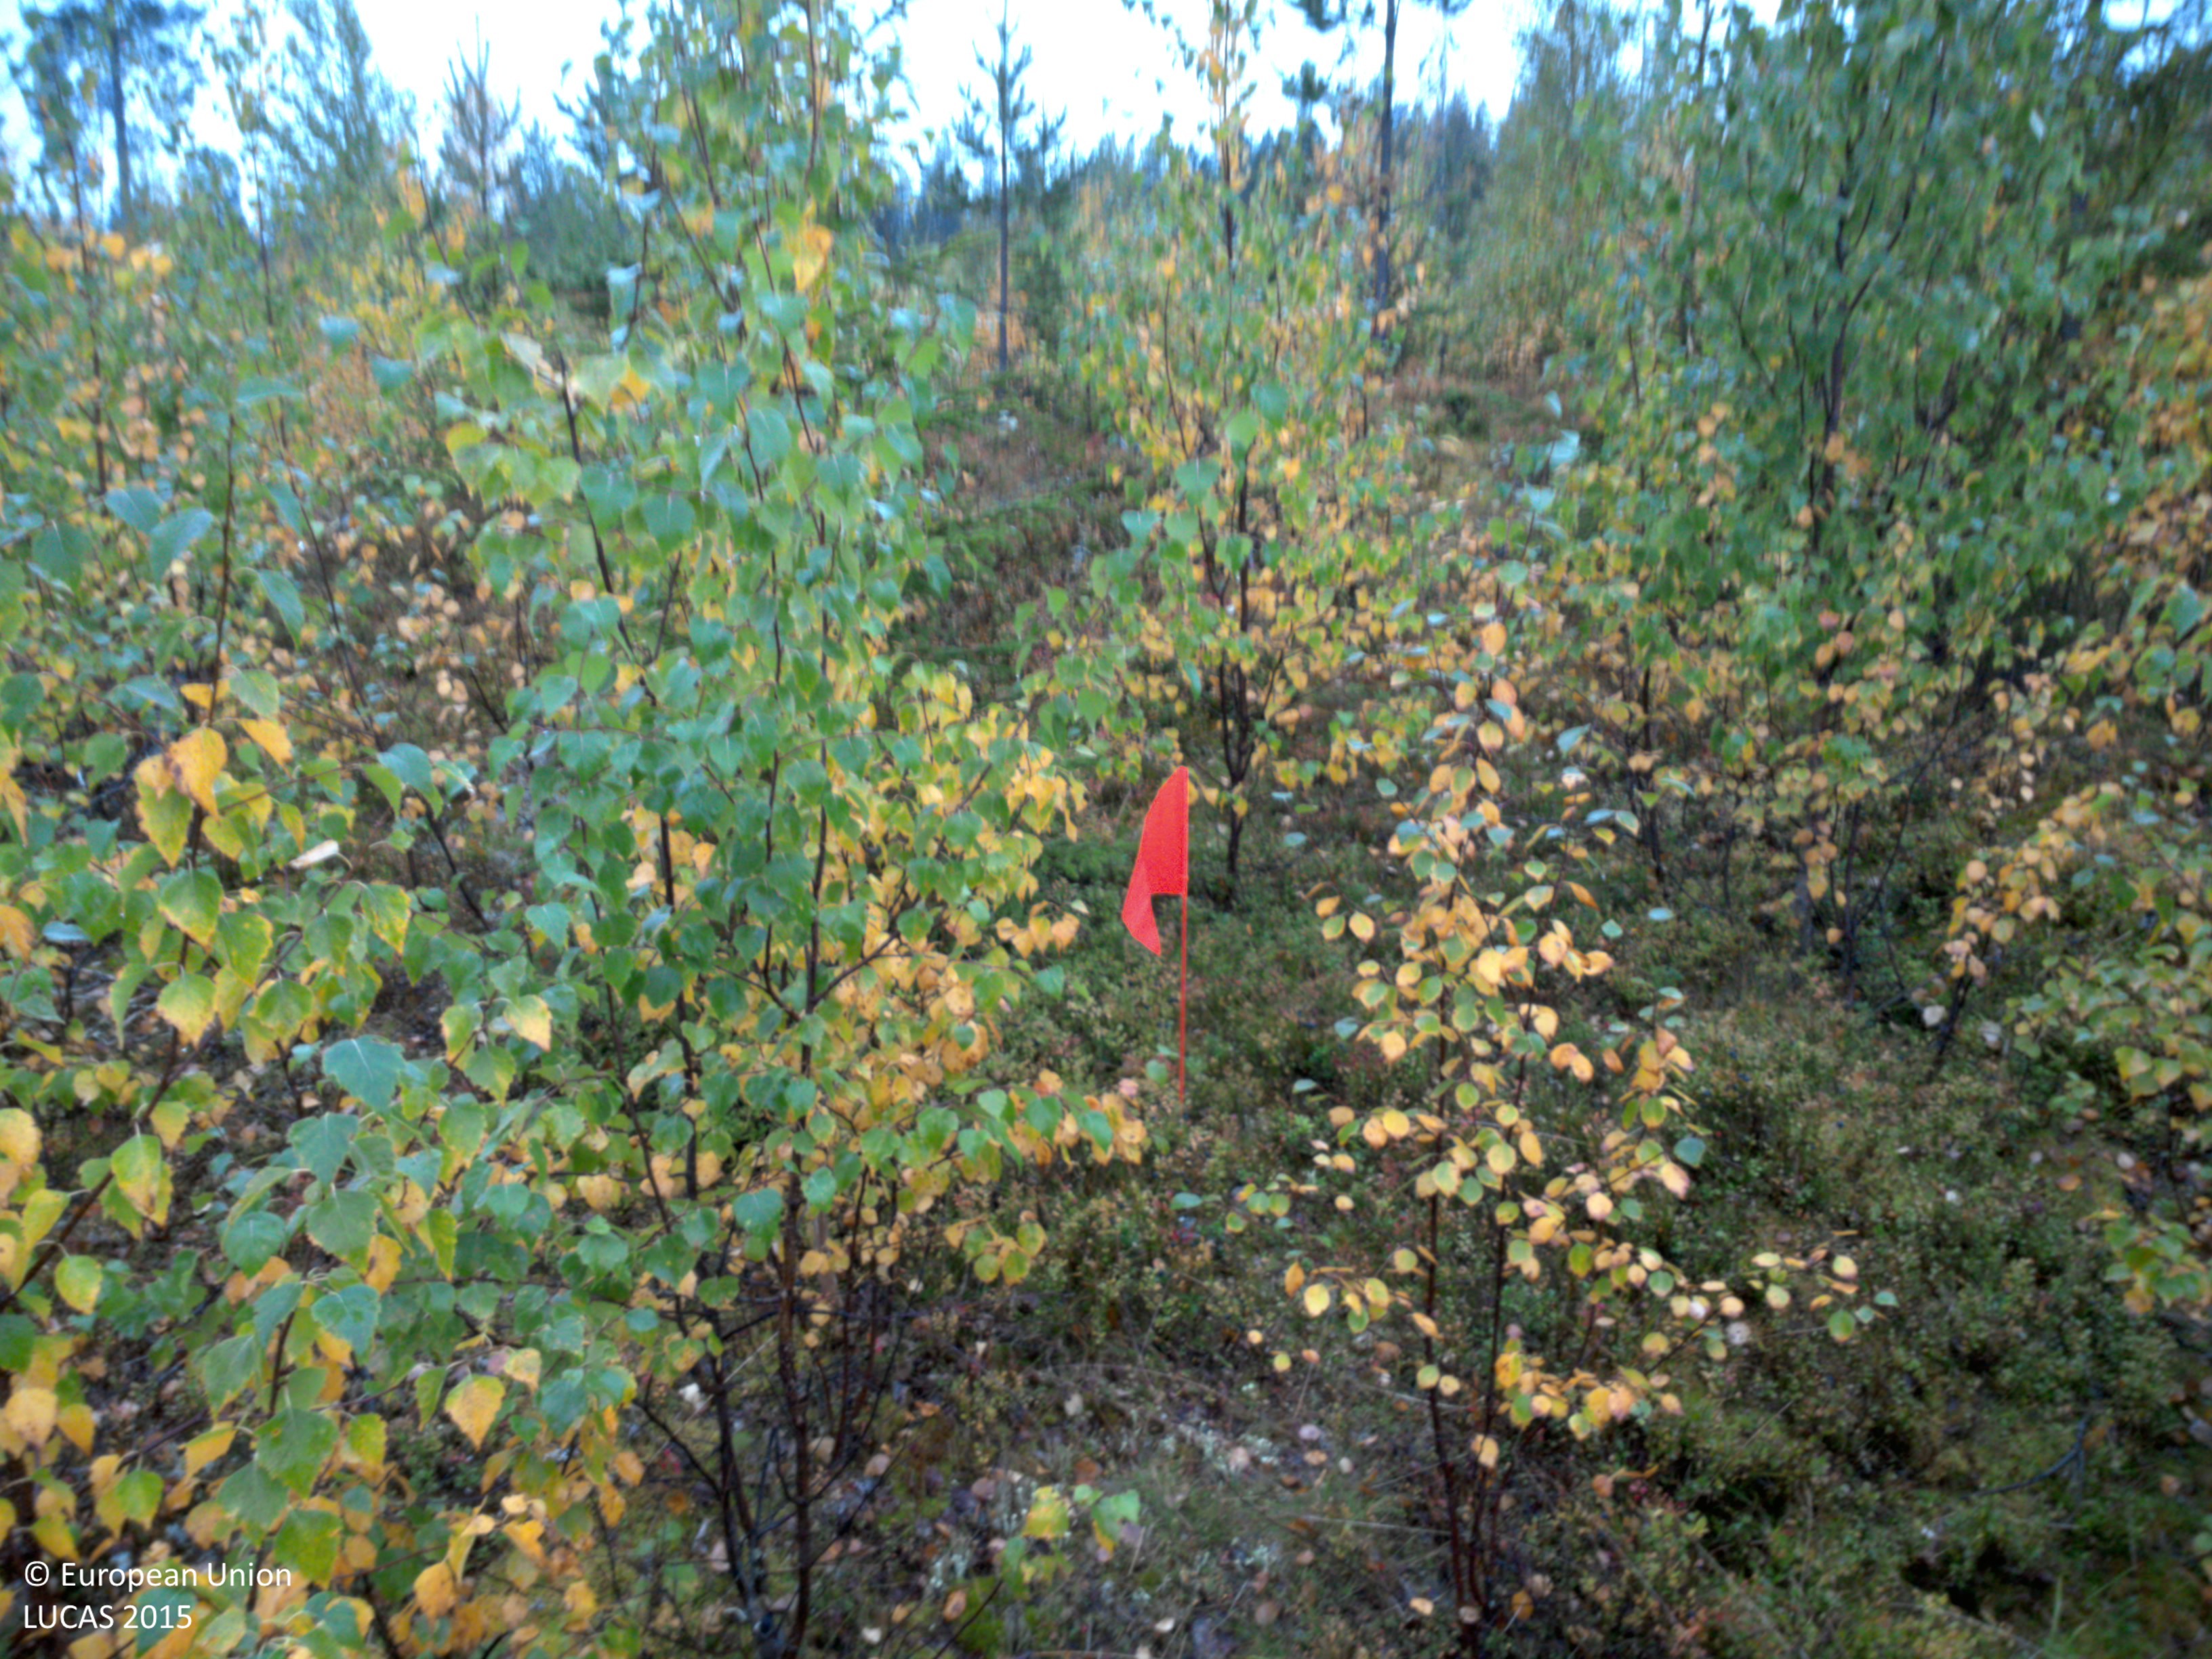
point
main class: Woodland
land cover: Spruce dominated mixed woodland
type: boreal forest
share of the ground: 50 - 75 %
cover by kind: coniferous forest trees 40 %, broadleaved forest trees 30 %, shrubs 25 %, herbaceous plants 5 %
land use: Forestry
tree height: < 5 m
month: September
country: SE
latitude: 64.9134
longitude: 19.2042
